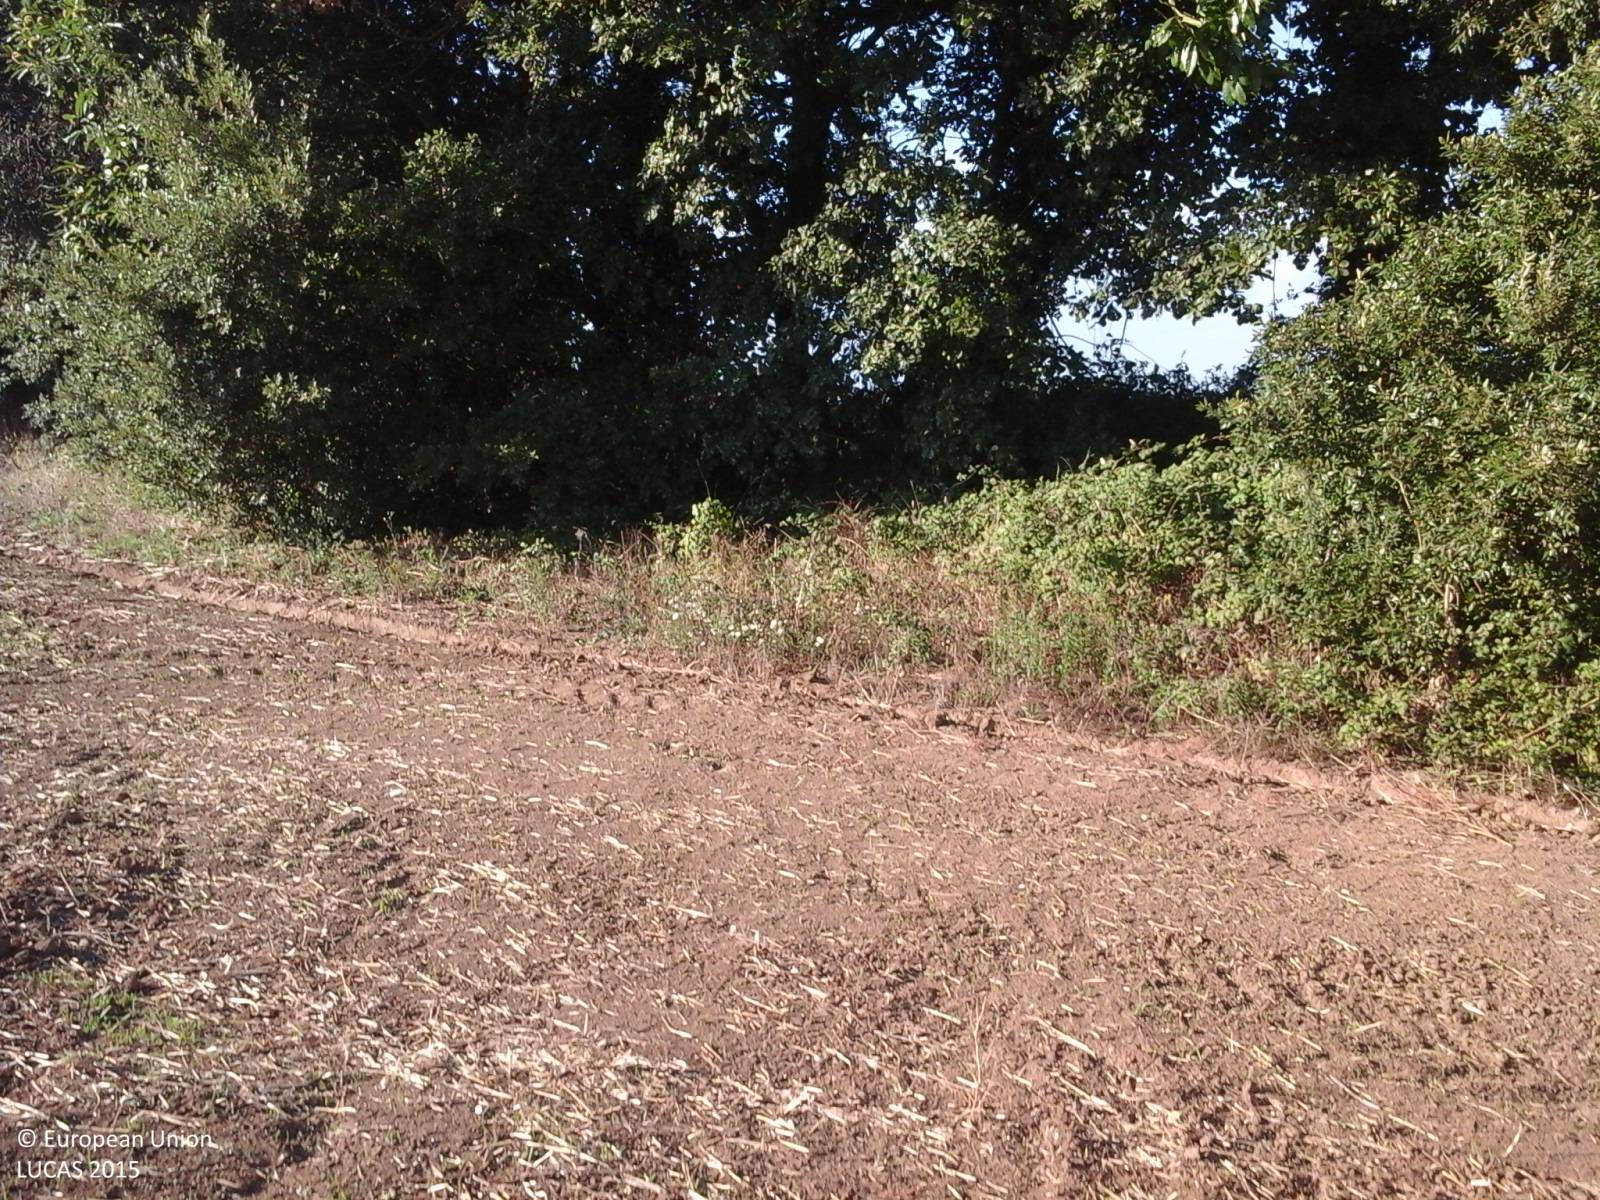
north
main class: Cropland
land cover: Oats
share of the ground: < 10 %
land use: Agriculture (excluding fallow land and kitchen gardens)
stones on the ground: < 10 %
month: September
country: IT
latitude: 42.5467
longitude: 11.8569
